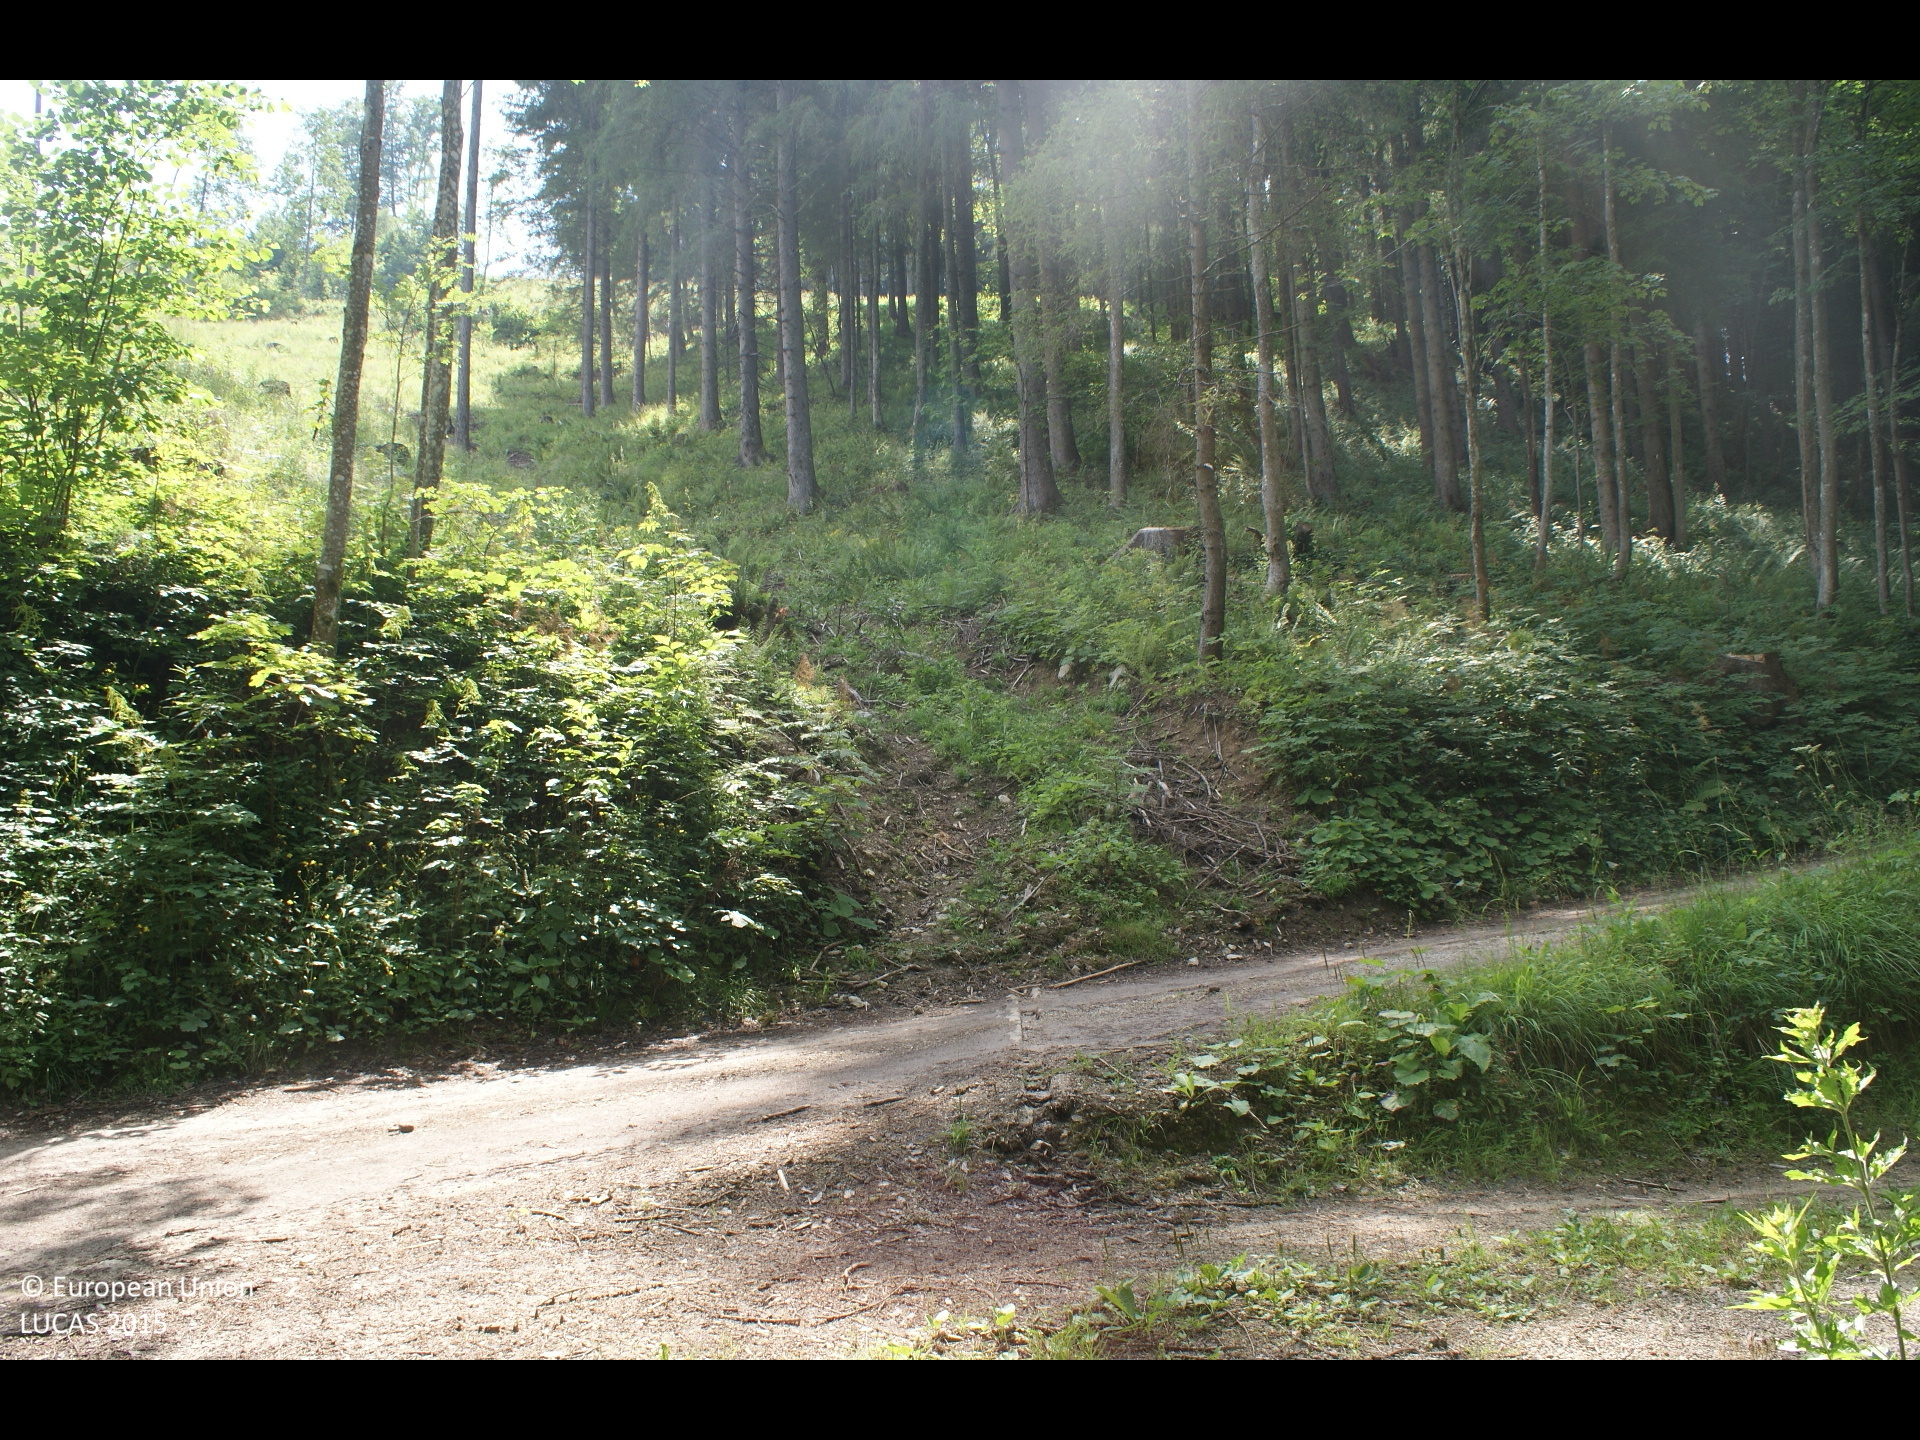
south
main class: Woodland
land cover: Spruce dominated mixed woodland
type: mesophytic deciduous forest
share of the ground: > 75 %
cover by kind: coniferous forest trees 55 %, broadleaved forest trees 30 %, herbaceous plants 10 %, shrubs 5 %
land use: Forestry
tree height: > 5 m
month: July
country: AT
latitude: 47.8600
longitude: 15.3345
